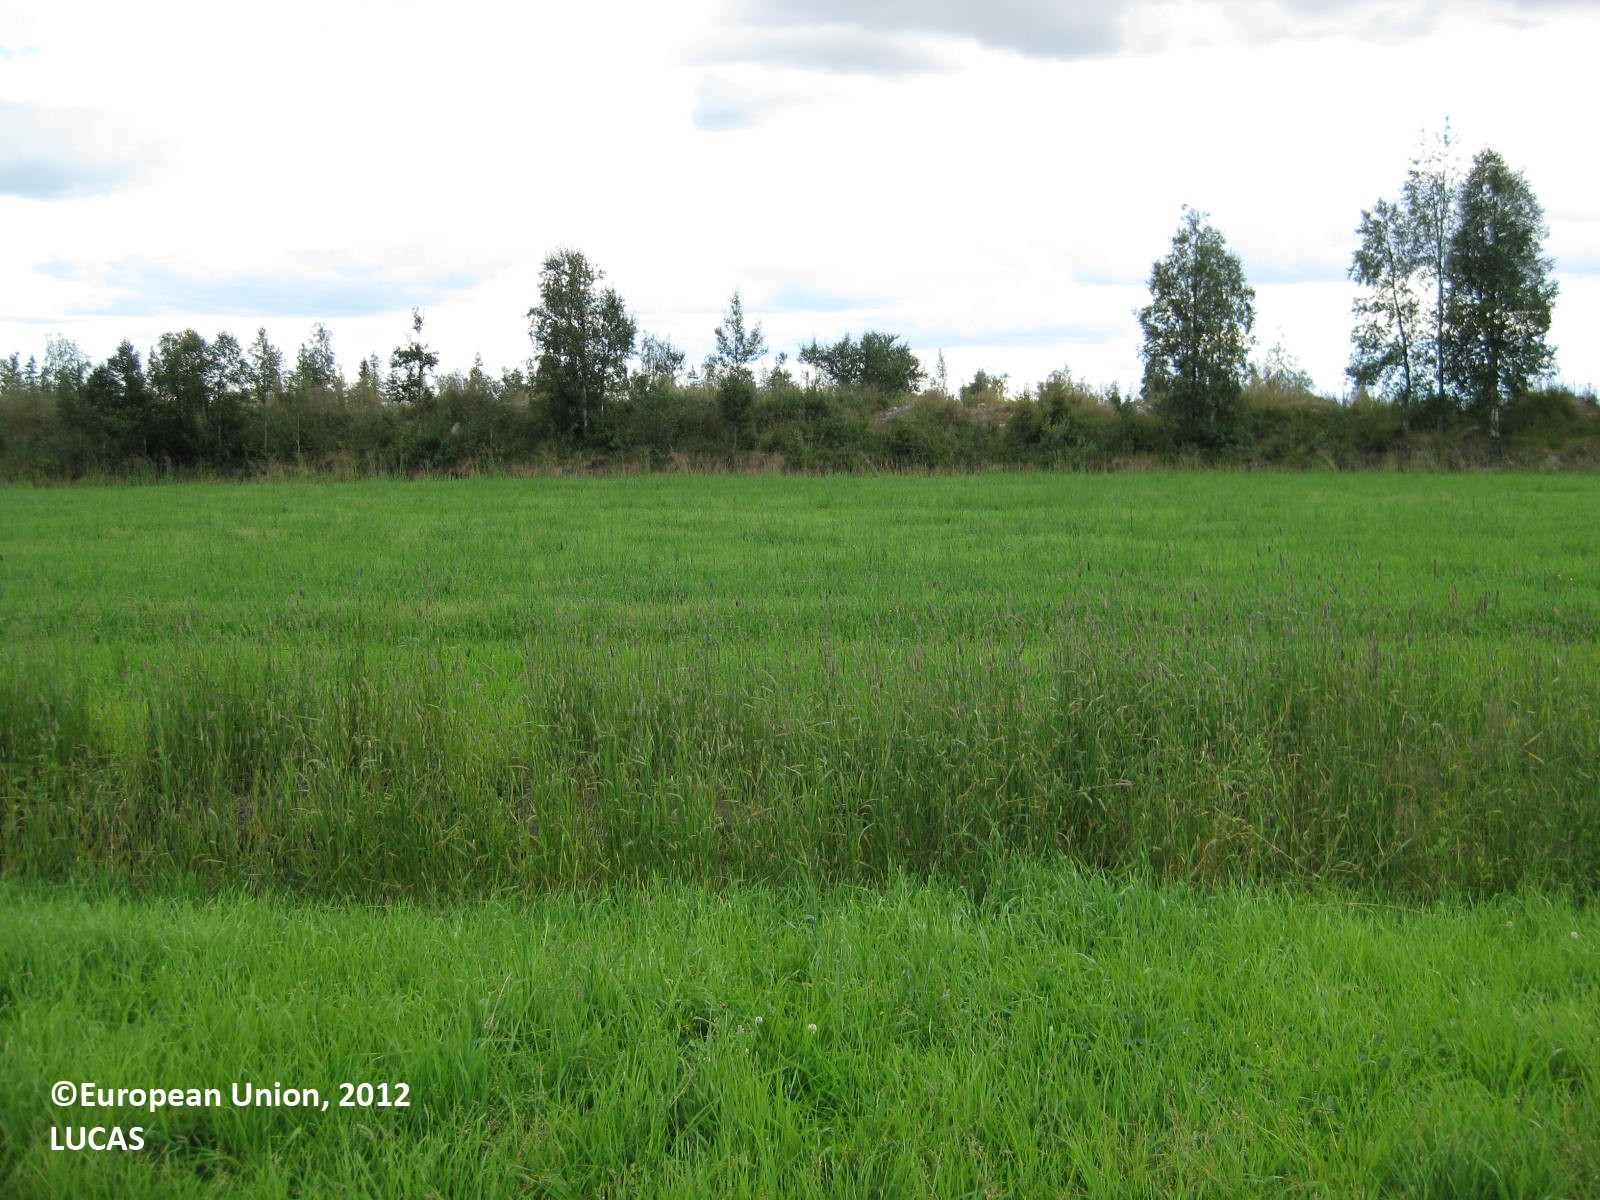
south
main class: Cropland
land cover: Temporary grasslands
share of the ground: > 75 %
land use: Agriculture (excluding fallow land and kitchen gardens)
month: August
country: FI
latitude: 66.4359
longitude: 28.5061
